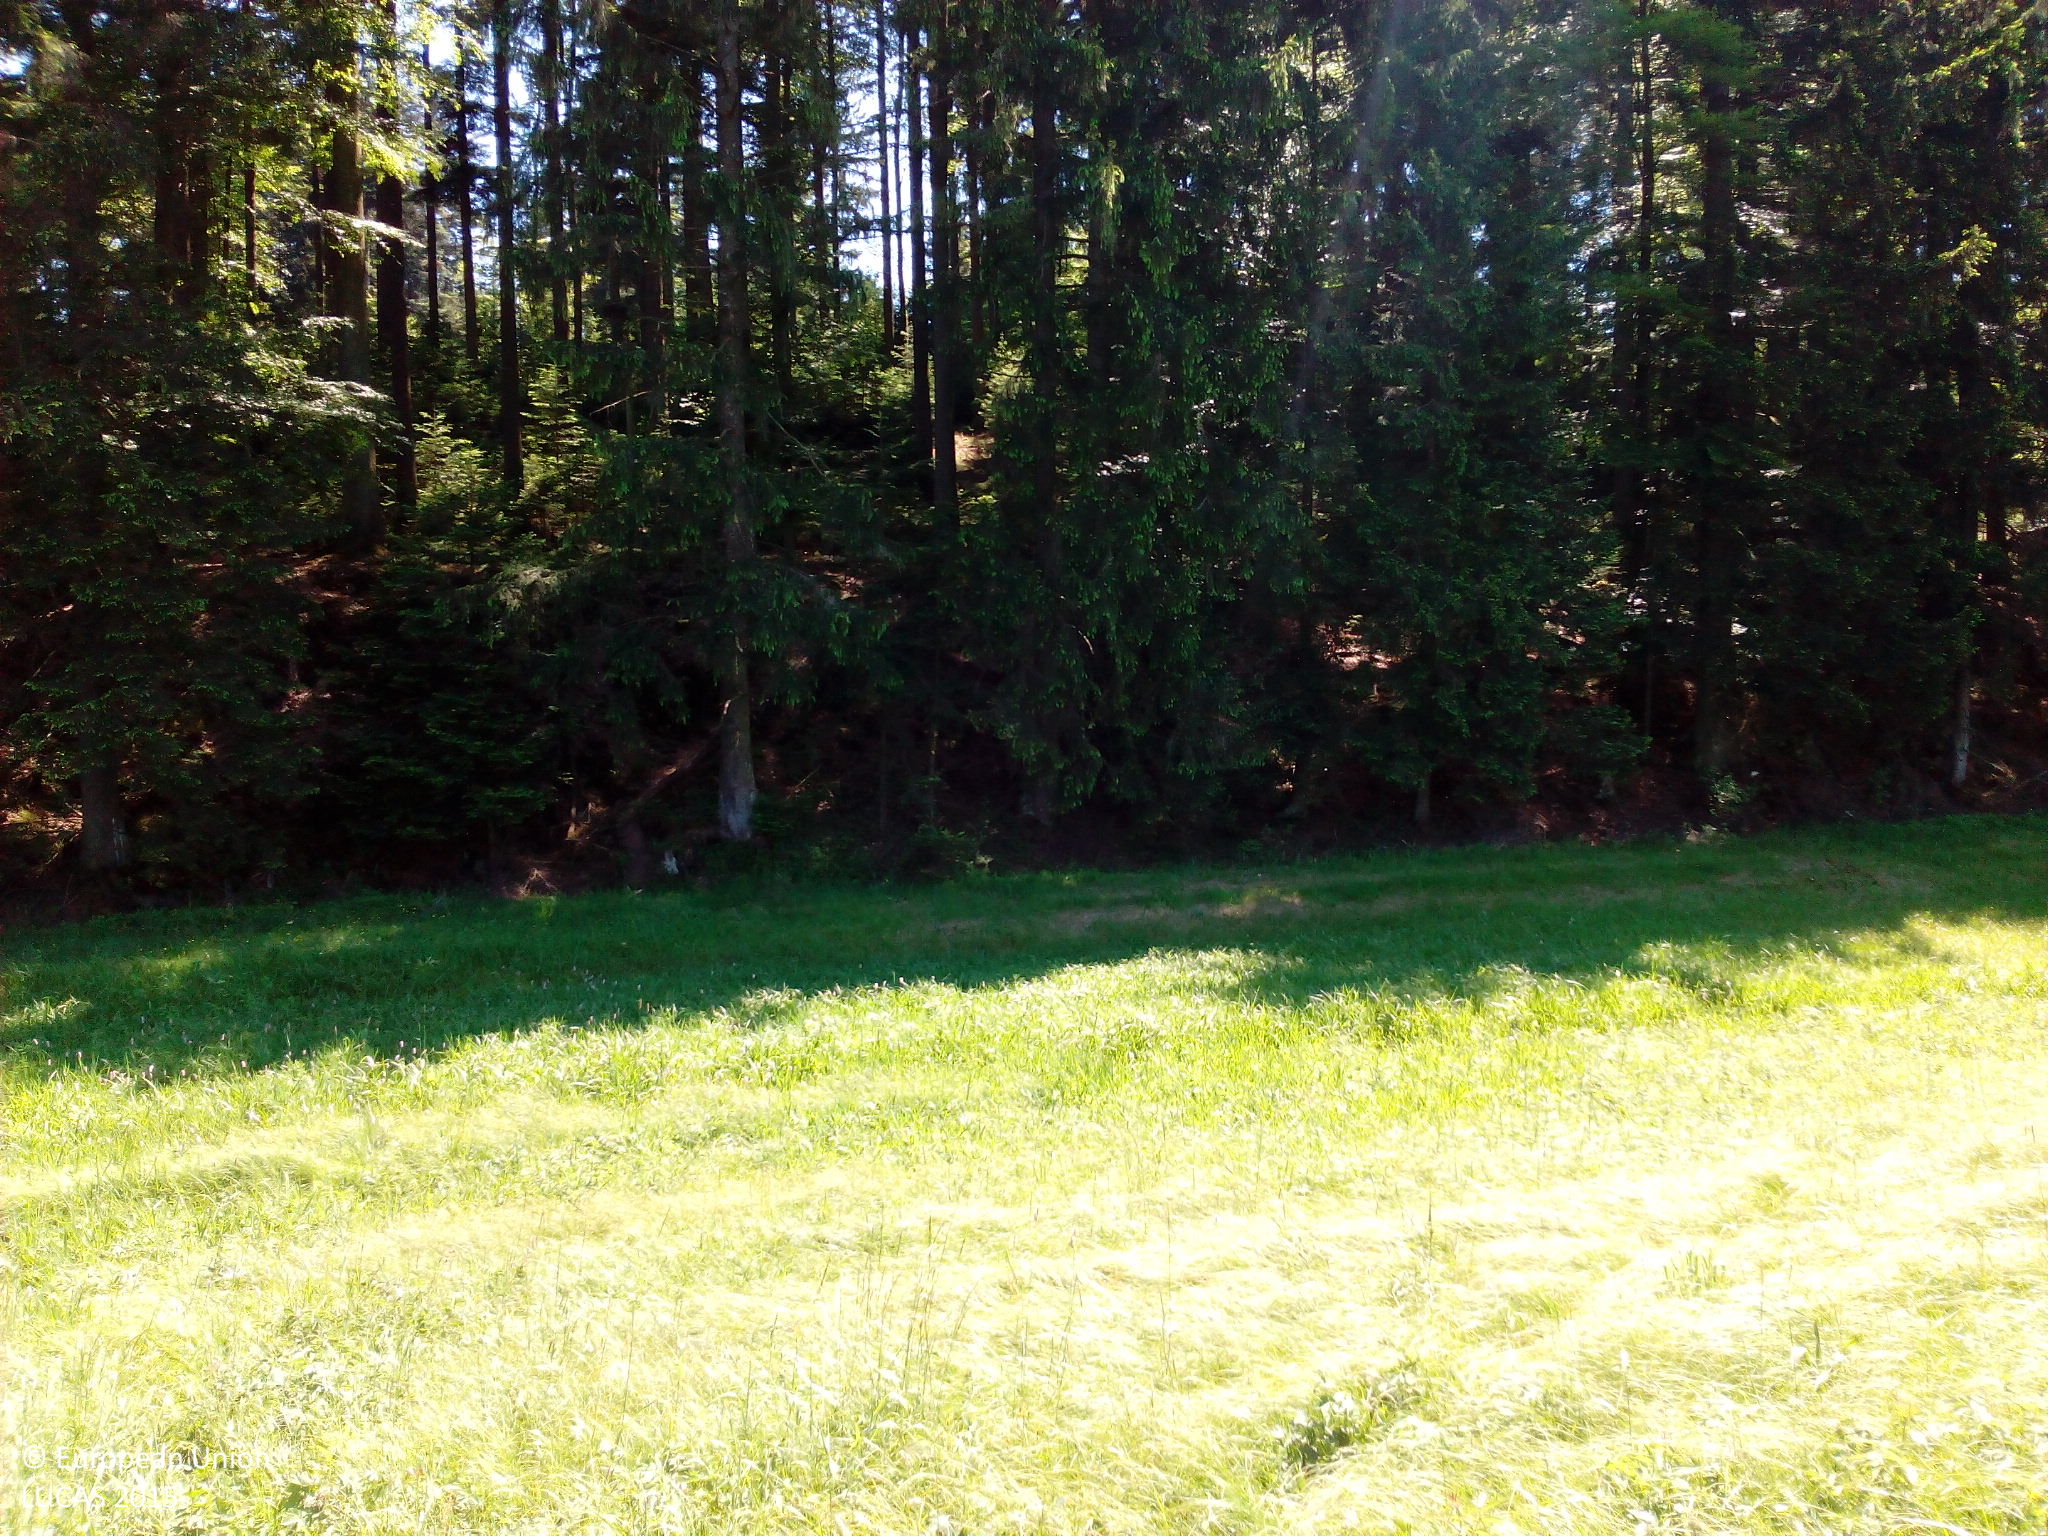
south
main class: Grassland
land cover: Grassland without tree/shrub cover
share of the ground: > 75 %
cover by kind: herbaceous plants 100 %
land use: Agriculture (excluding fallow land and kitchen gardens)
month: June
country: DE
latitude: 48.9248
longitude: 9.6862
